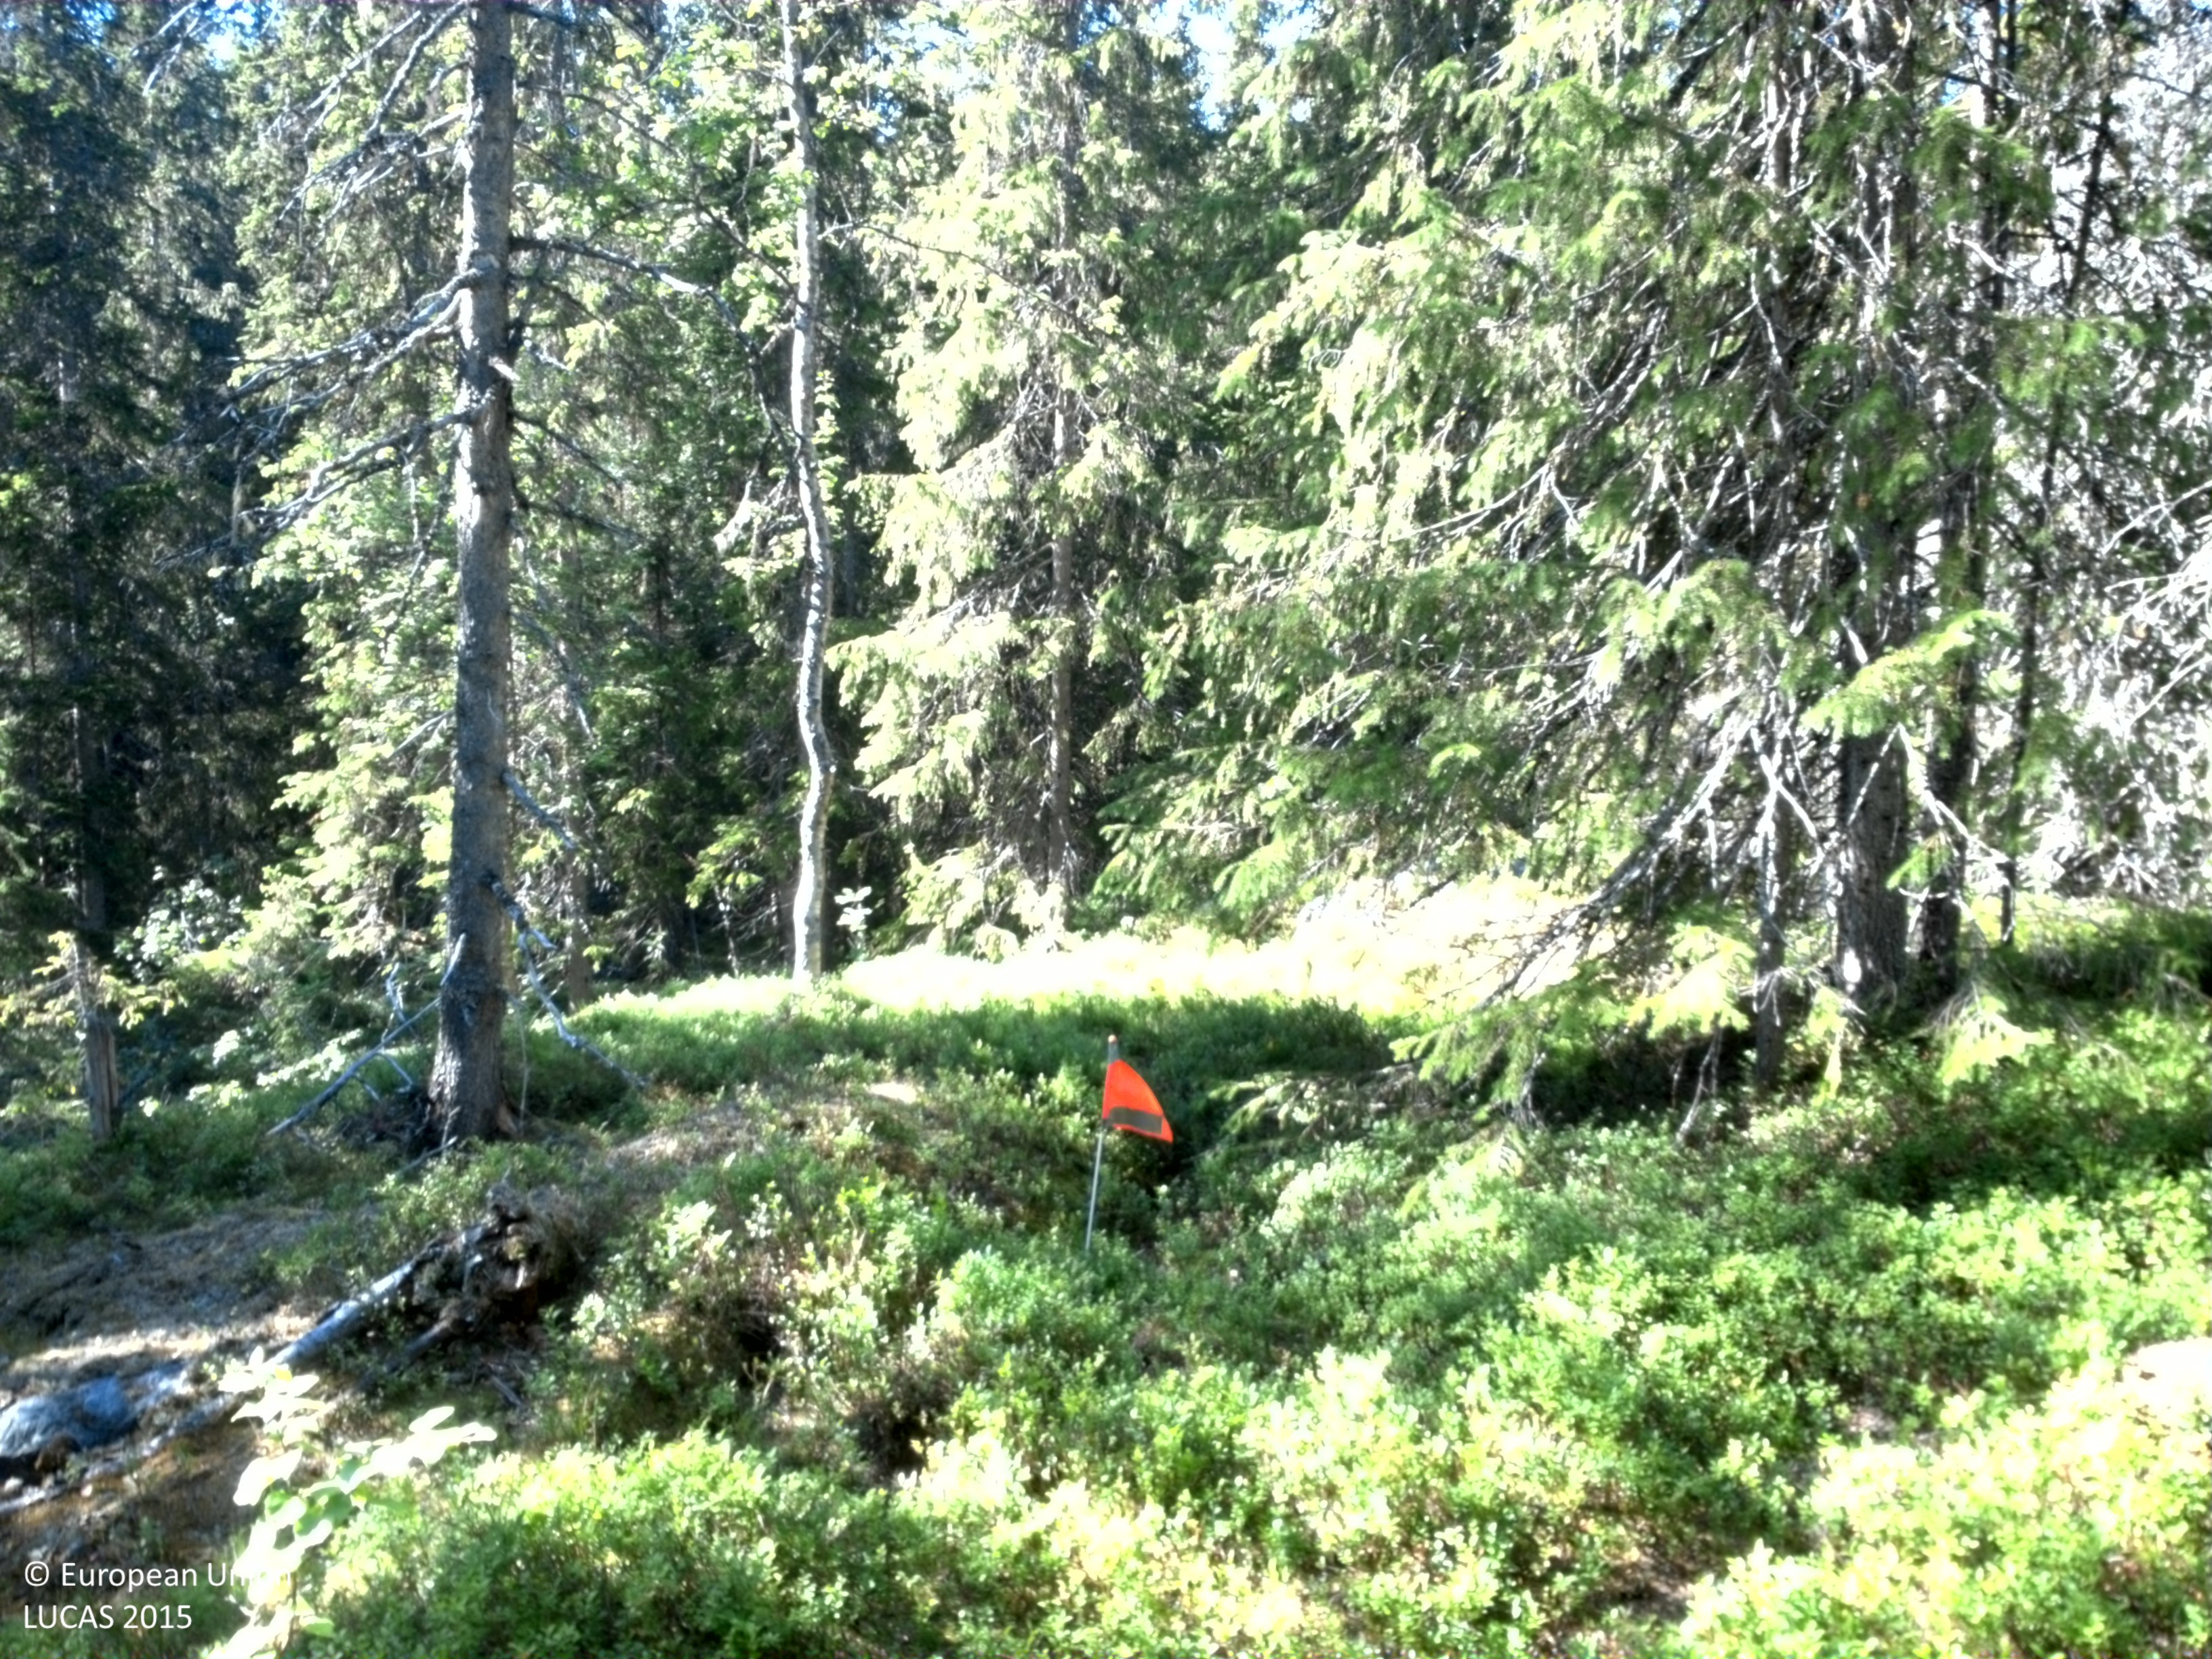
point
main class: Woodland
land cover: Spruce dominated coniferous woodland
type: boreal forest
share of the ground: 25 - 50 %
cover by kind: shrubs 50 %, coniferous forest trees 35 %, lichens and mosses 15 %
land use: Forestry
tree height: > 5 m
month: August
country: SE
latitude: 64.8728
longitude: 15.7715
